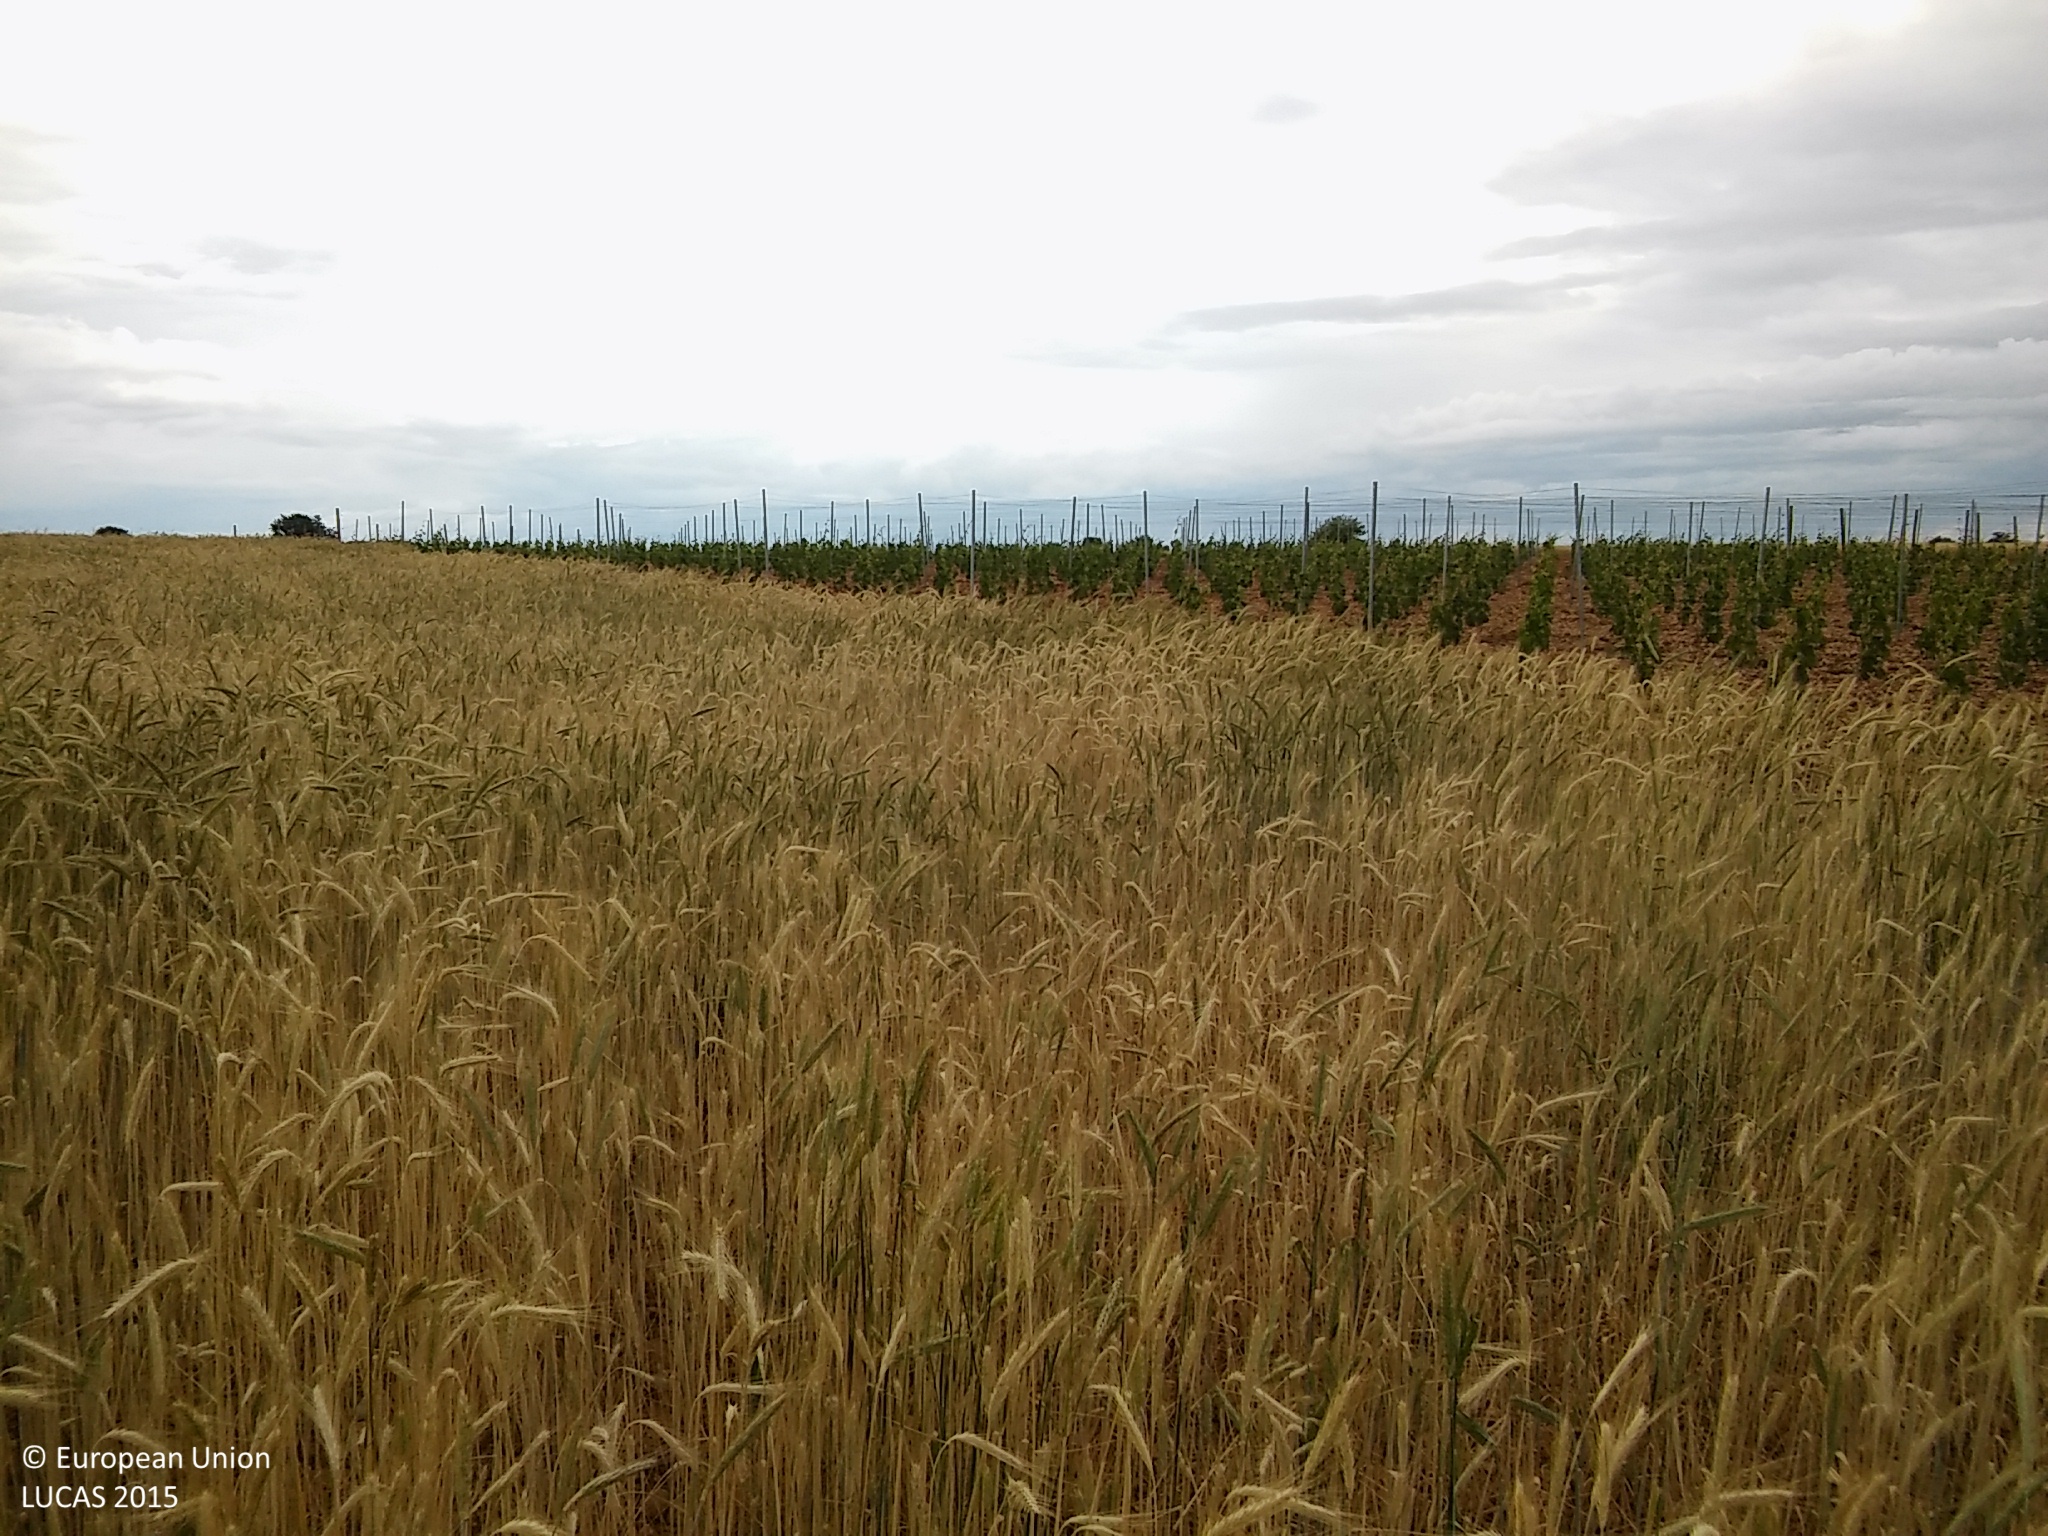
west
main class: Cropland
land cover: Rye
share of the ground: > 75 %
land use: Agriculture (excluding fallow land and kitchen gardens)
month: June
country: ES
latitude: 41.5217
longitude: -3.7976
